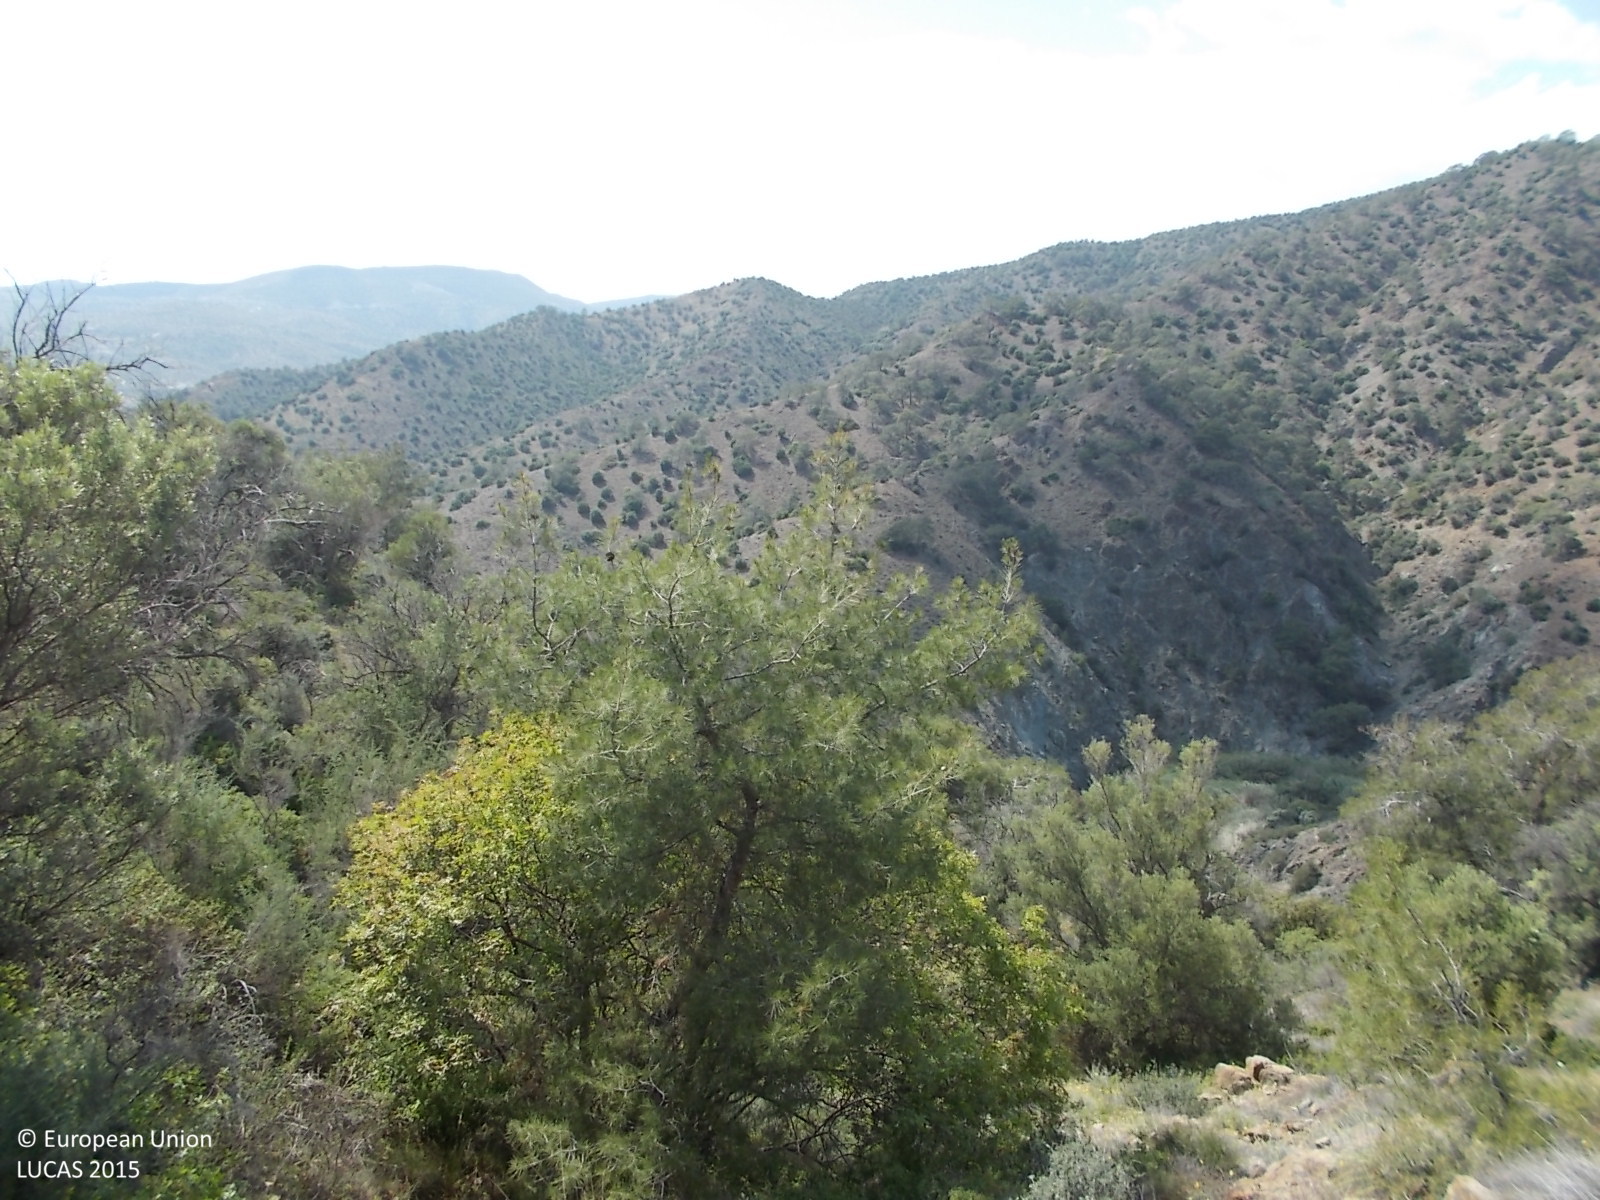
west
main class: Shrubland
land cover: Shrubland with sparse tree cover
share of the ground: > 75 %
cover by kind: shrubs 95 %, broadleaved forest trees 5 %
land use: Semi-natural and natural areas not in use
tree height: > 5 m
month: April
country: CY
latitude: 34.7674
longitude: 33.1036
